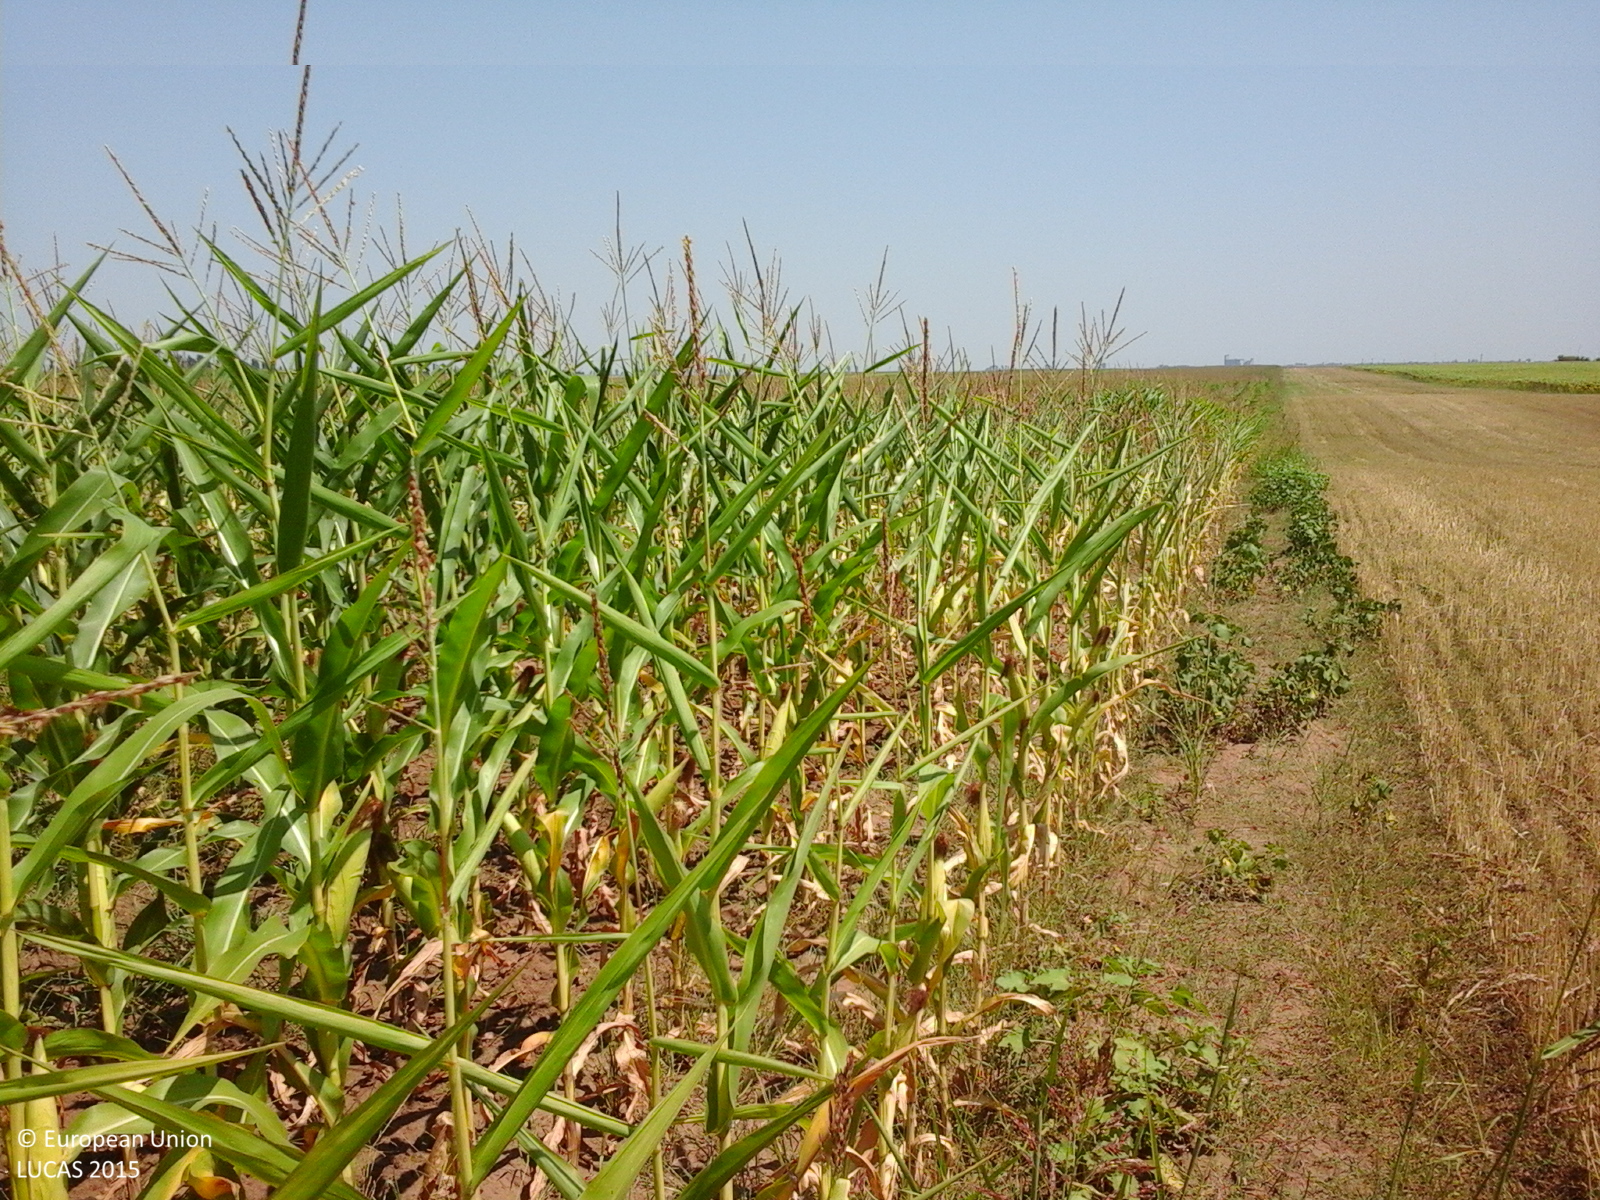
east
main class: Cropland
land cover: Maize
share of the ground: > 75 %
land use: Agriculture (excluding fallow land and kitchen gardens)
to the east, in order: Maize
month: July
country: RO
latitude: 44.9003
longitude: 27.3533
